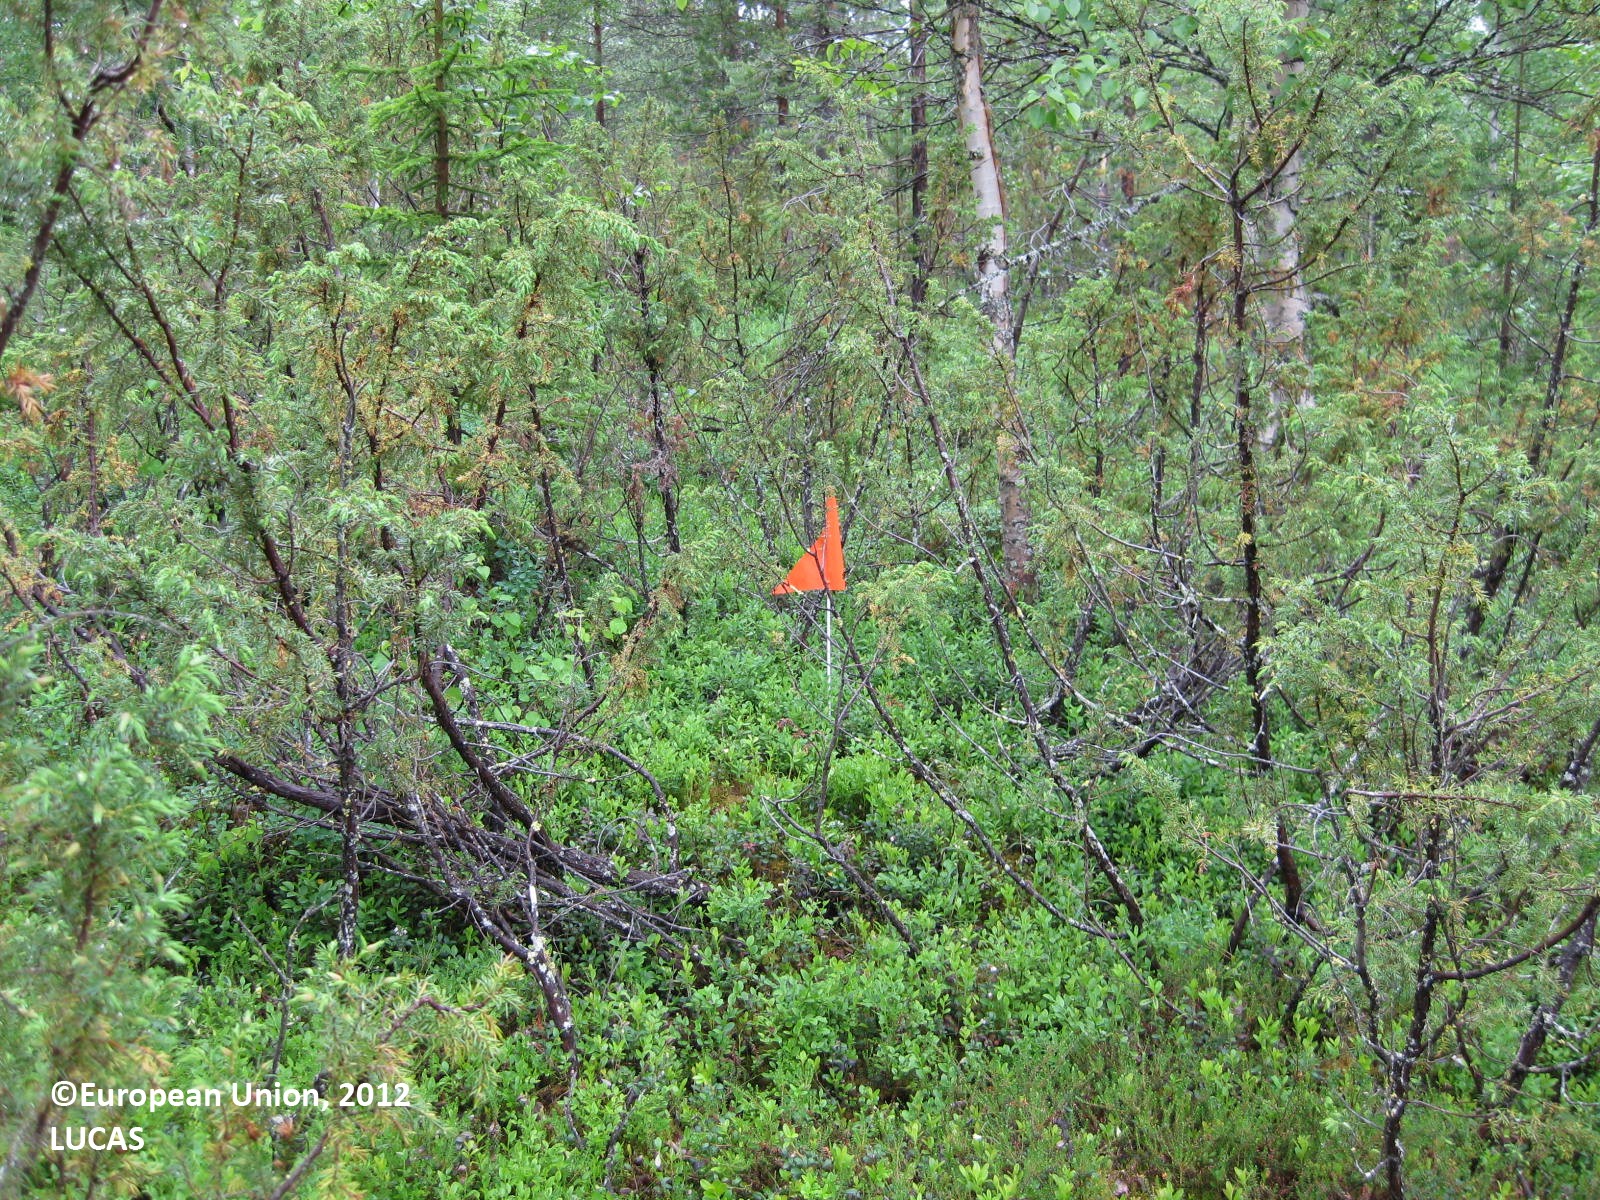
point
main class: Woodland
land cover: Pine dominated mixed woodland
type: boreal forest
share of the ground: > 75 %
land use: Forestry
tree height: > 5 m
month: July
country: FI
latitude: 65.4577
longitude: 28.2118
